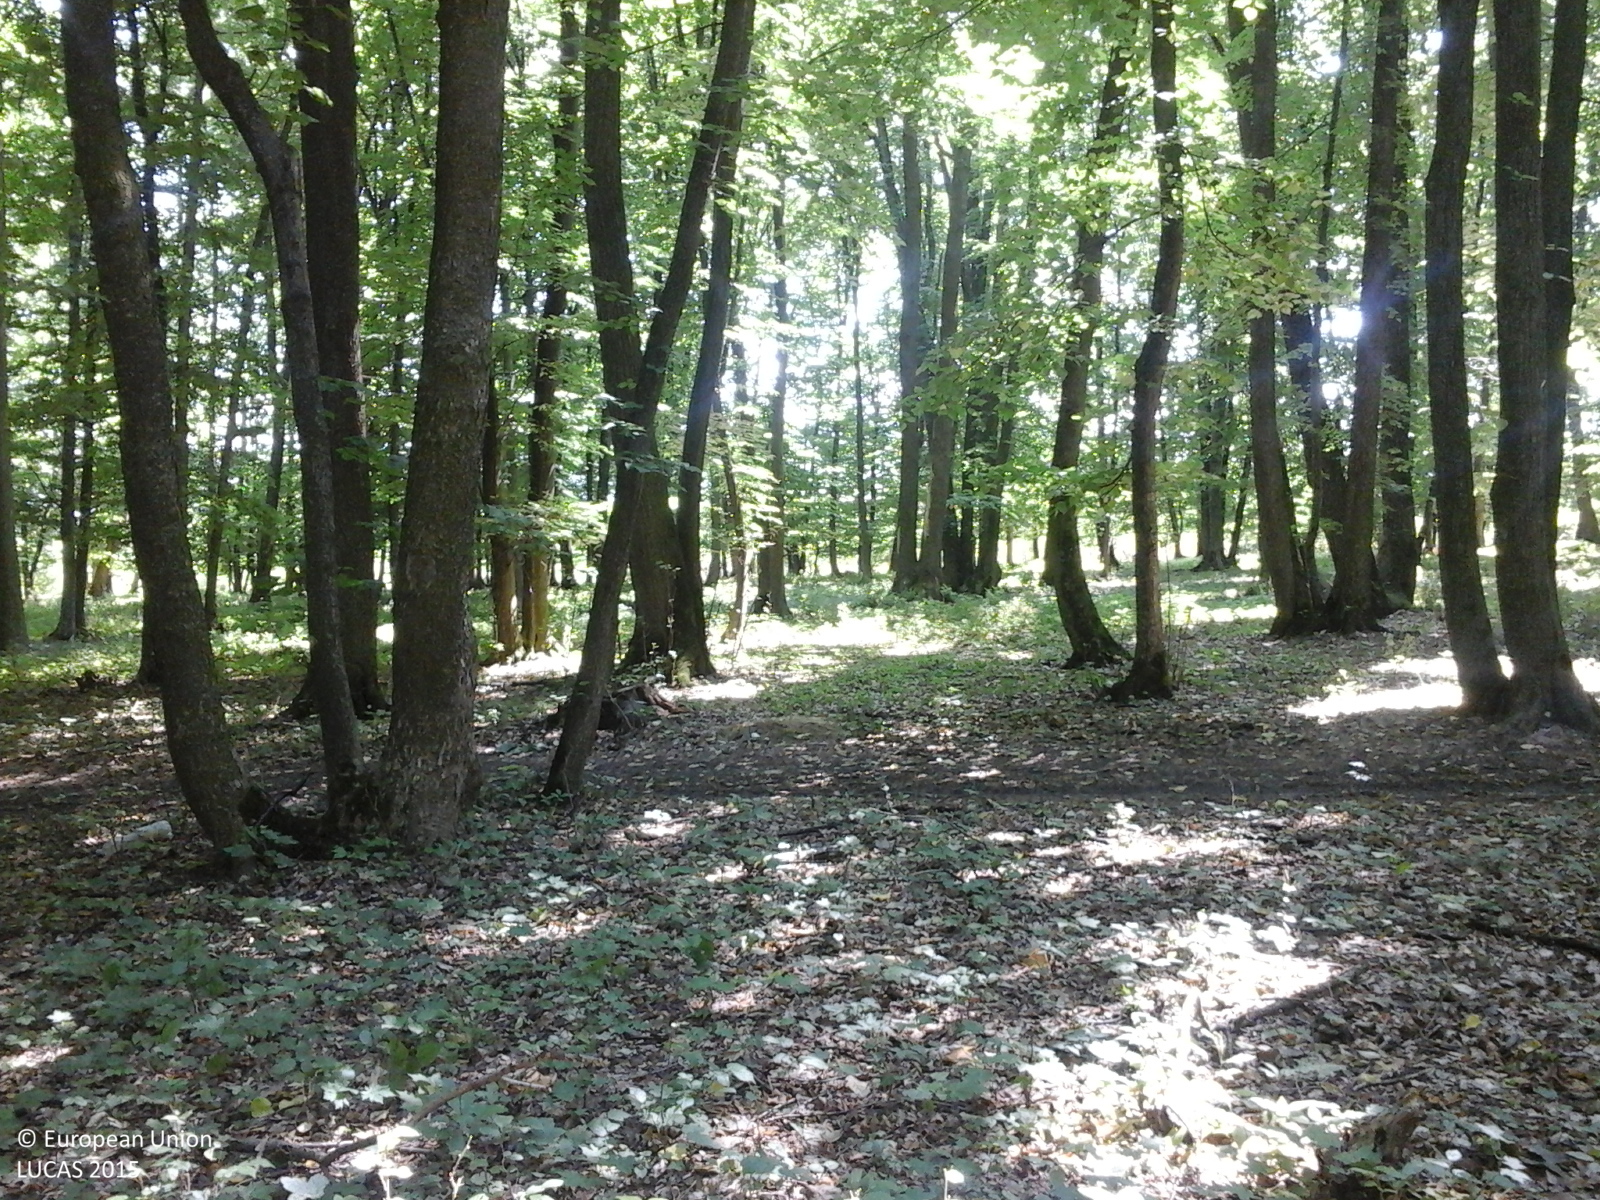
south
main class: Woodland
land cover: Broadleaved woodland
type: acidophilous oak and oak-birch forest
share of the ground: > 75 %
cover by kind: broadleaved forest trees 100 %
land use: Forestry
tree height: > 5 m
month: June
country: RO
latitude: 47.3558
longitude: 26.8451
